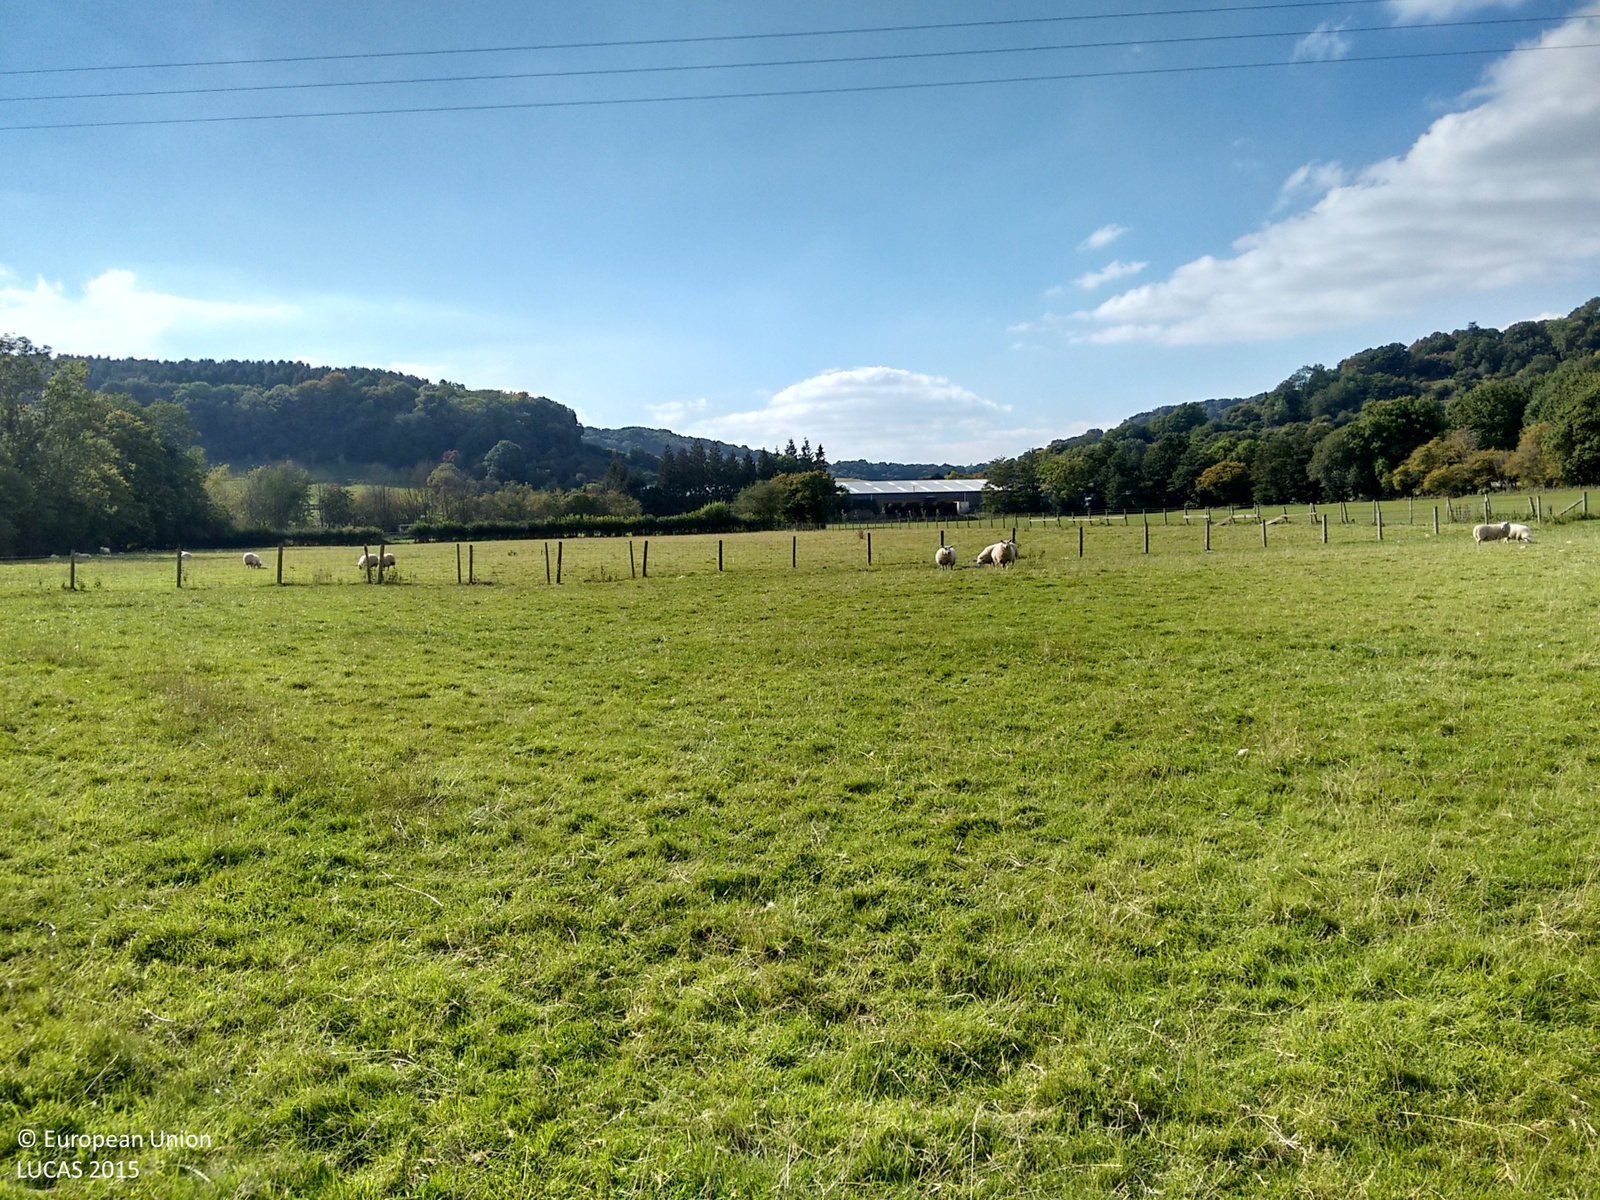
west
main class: Grassland
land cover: Grassland without tree/shrub cover
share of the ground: > 75 %
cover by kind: herbaceous plants 100 %
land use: Agriculture (excluding fallow land and kitchen gardens)
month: September
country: GB
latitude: 51.8642
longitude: -2.4528
